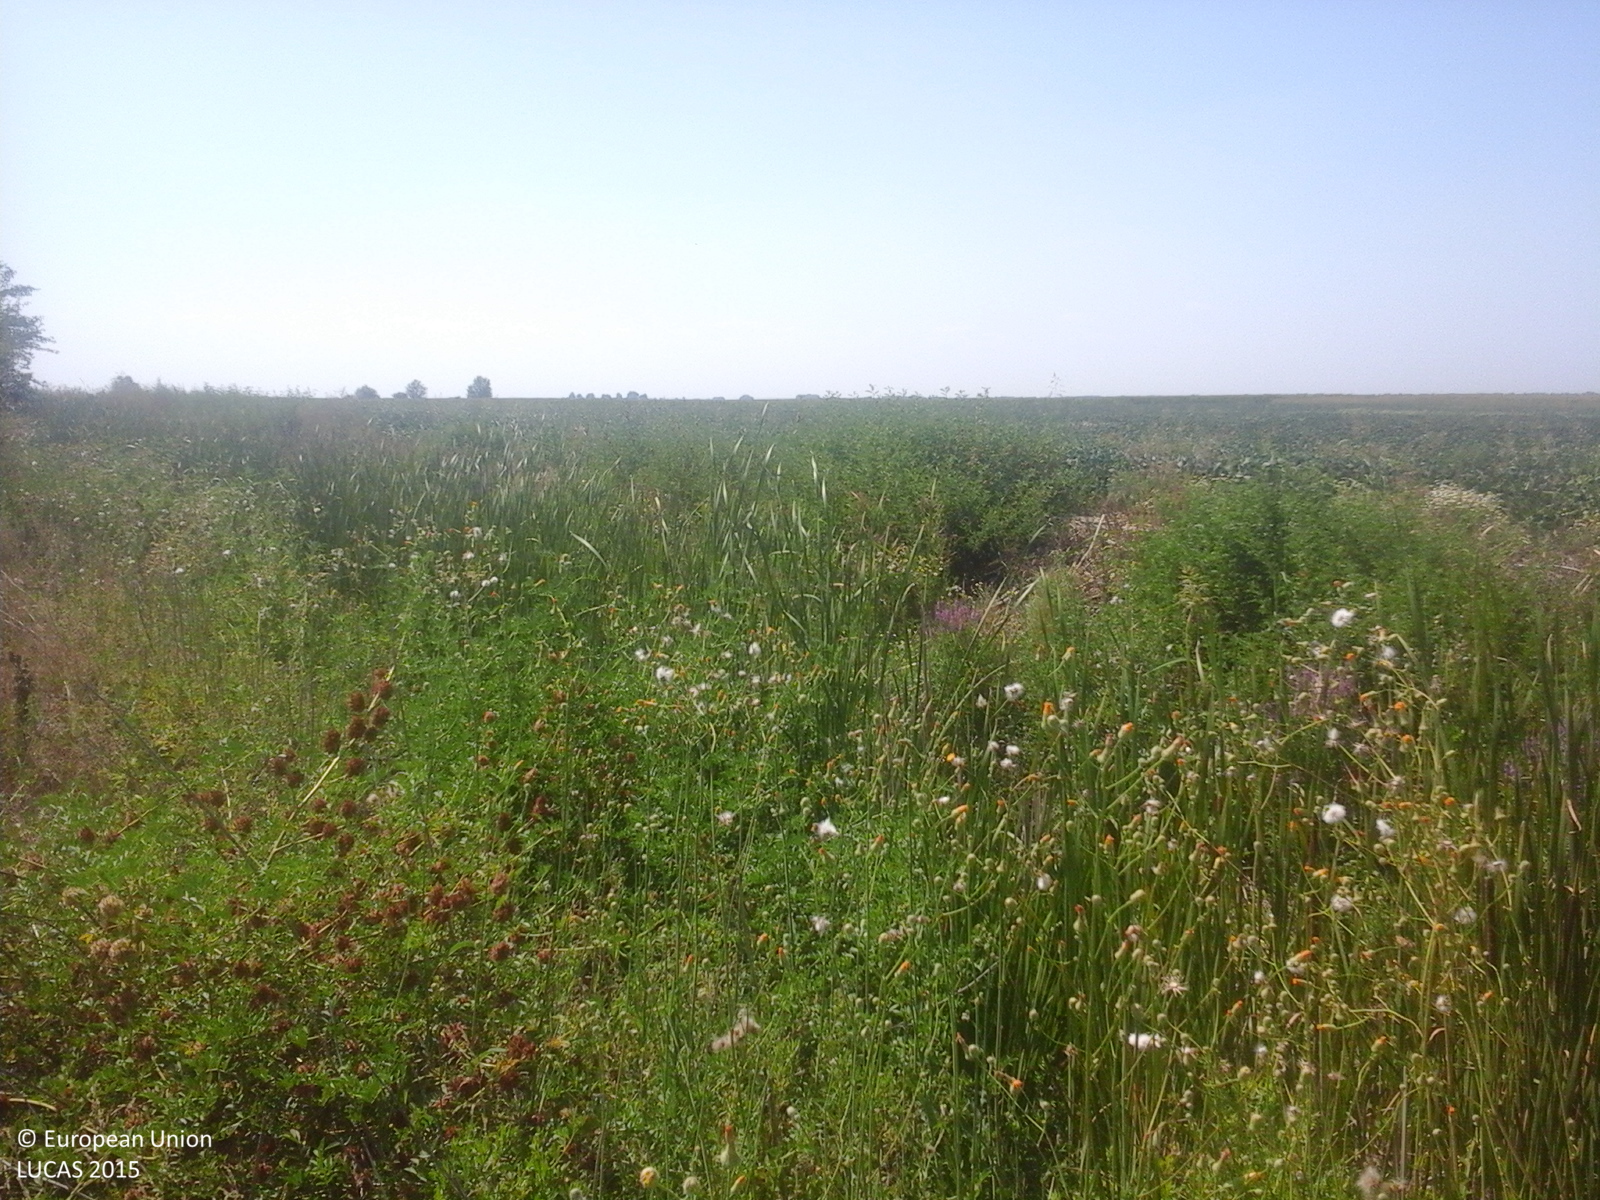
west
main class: Cropland
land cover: Soya
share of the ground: > 75 %
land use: Agriculture (excluding fallow land and kitchen gardens)
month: July
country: RO
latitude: 44.1926
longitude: 27.1835
